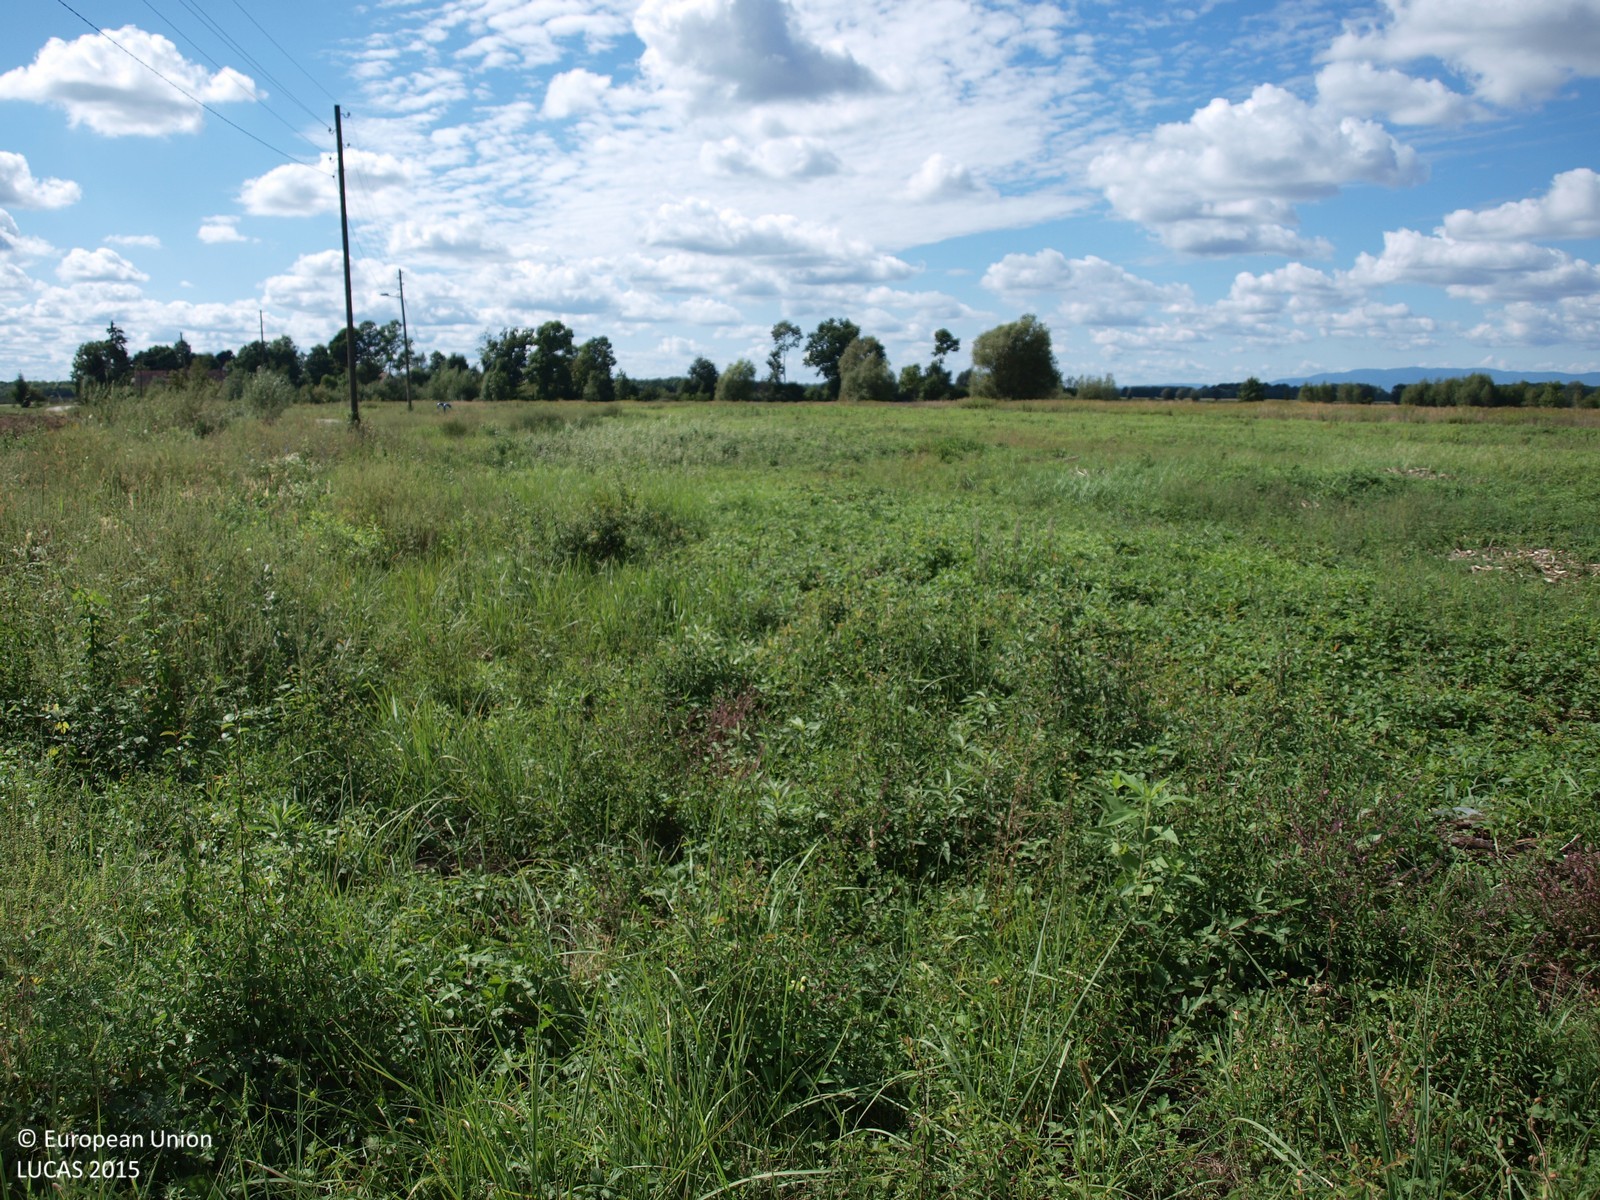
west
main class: Grassland
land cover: Grassland without tree/shrub cover
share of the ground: > 75 %
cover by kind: herbaceous plants 100 %
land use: Semi-natural and natural areas not in use
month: September
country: HR
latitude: 45.7283
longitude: 16.3591
